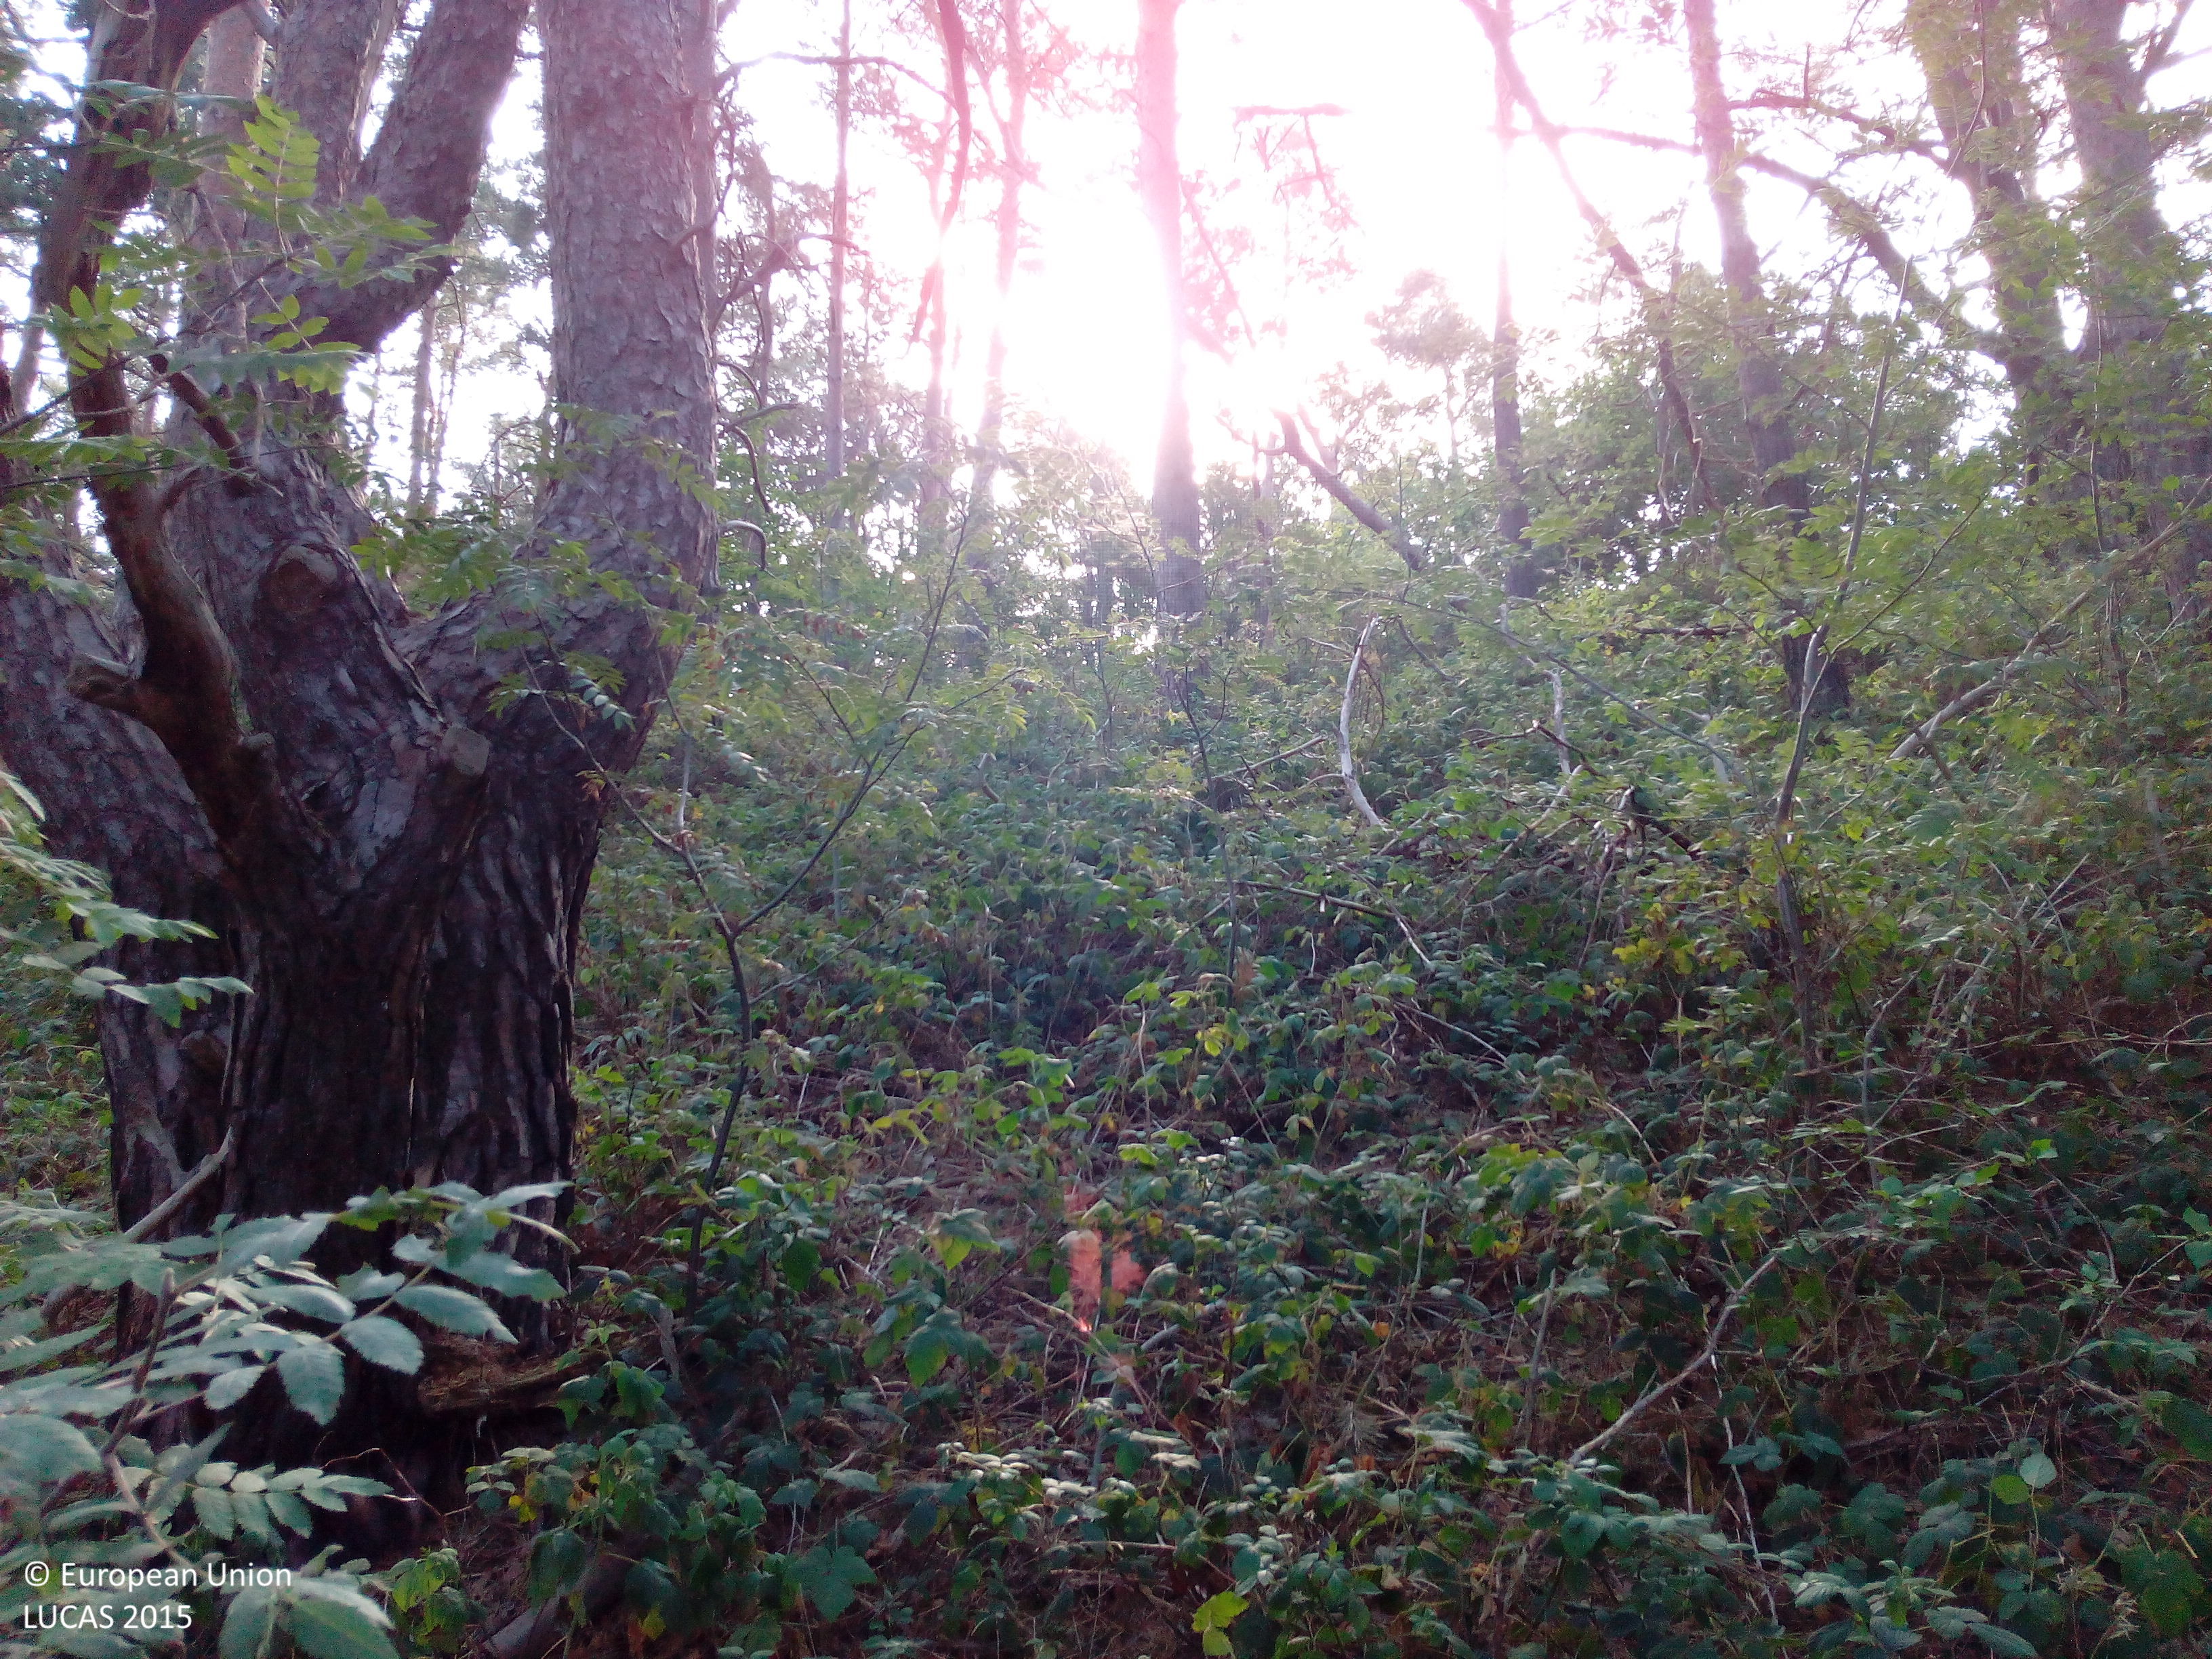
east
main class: Woodland
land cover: Pine dominated coniferous woodland
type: hemiboreal forest and nemoral coniferous forest and mixed broadleaved-coniferous forest
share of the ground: > 75 %
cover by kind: coniferous forest trees 90 %, herbaceous plants 10 %
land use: Forestry
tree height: > 5 m
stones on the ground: < 10 %
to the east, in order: Pine dominated coniferous woodland; Tracks; Pine dominated coniferous woodland
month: August
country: DE
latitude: 51.8165
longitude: 10.9426
